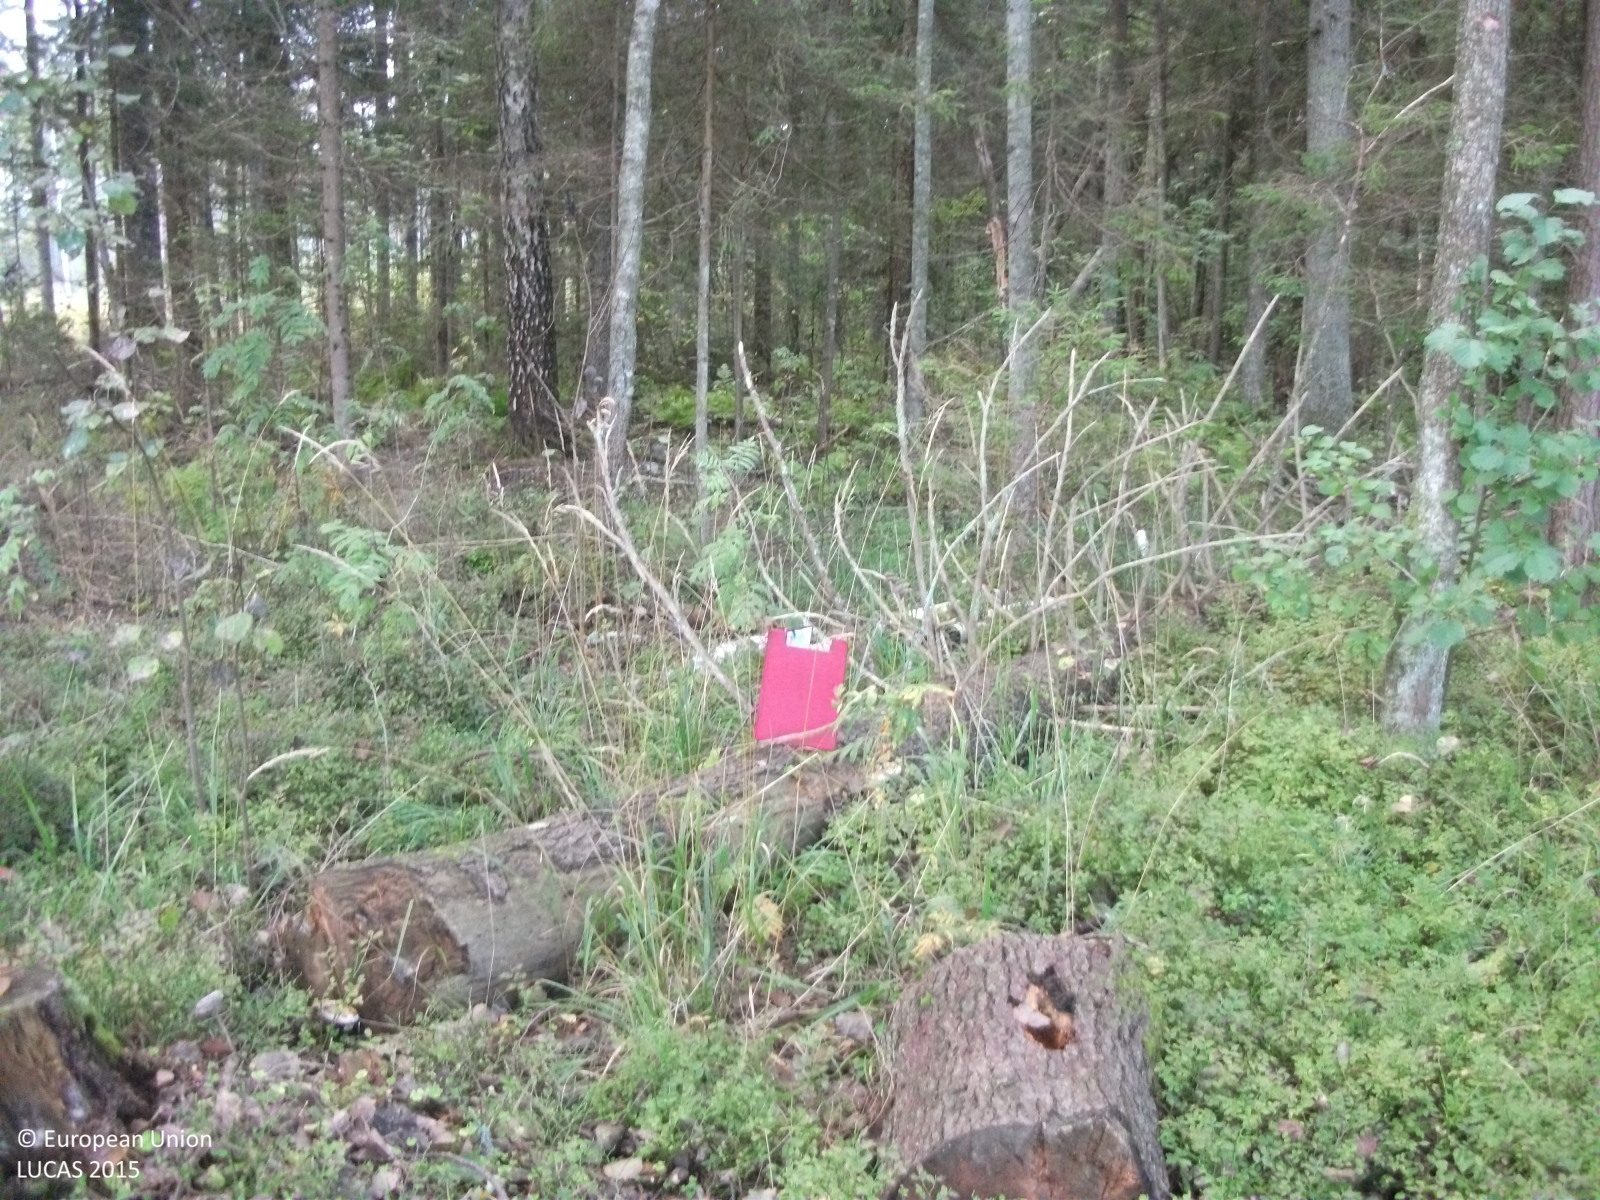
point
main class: Woodland
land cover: Spruce dominated coniferous woodland
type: hemiboreal forest and nemoral coniferous forest and mixed broadleaved-coniferous forest
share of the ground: > 75 %
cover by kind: coniferous forest trees 80 %, broadleaved forest trees 10 %, shrubs 5 %, herbaceous plants 5 %
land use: Forestry
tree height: > 5 m
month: September
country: LV
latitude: 57.9018
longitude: 24.5156
